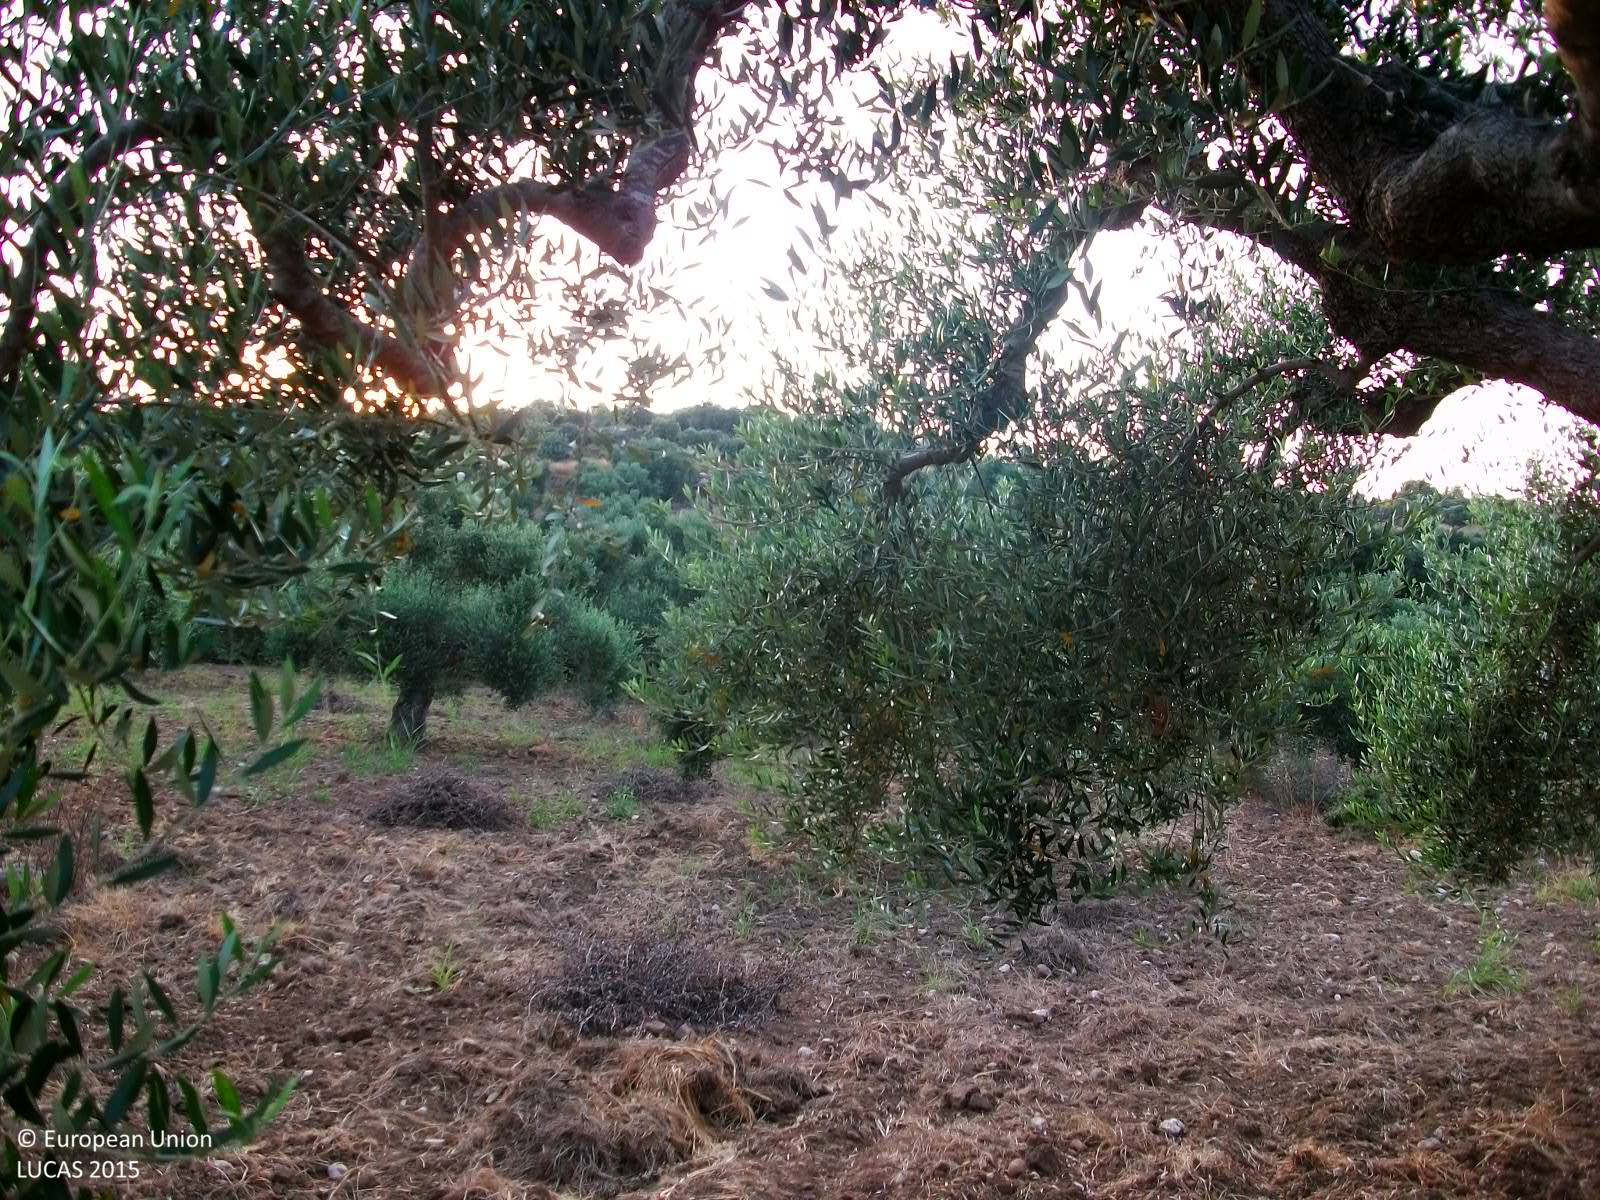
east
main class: Cropland
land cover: Olive groves
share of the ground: 25 - 50 %
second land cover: Other bare soil
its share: > 75 %
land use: Agriculture (excluding fallow land and kitchen gardens)
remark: Tilled/Sowed
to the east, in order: Olive groves; Other bare soil; Shrubland without tree cover; Olive groves; Dry stone walls; Olive groves; Dry stone walls; Olive groves; Shrubland without tree cover
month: July
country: GR
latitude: 36.7855
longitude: 21.8378
